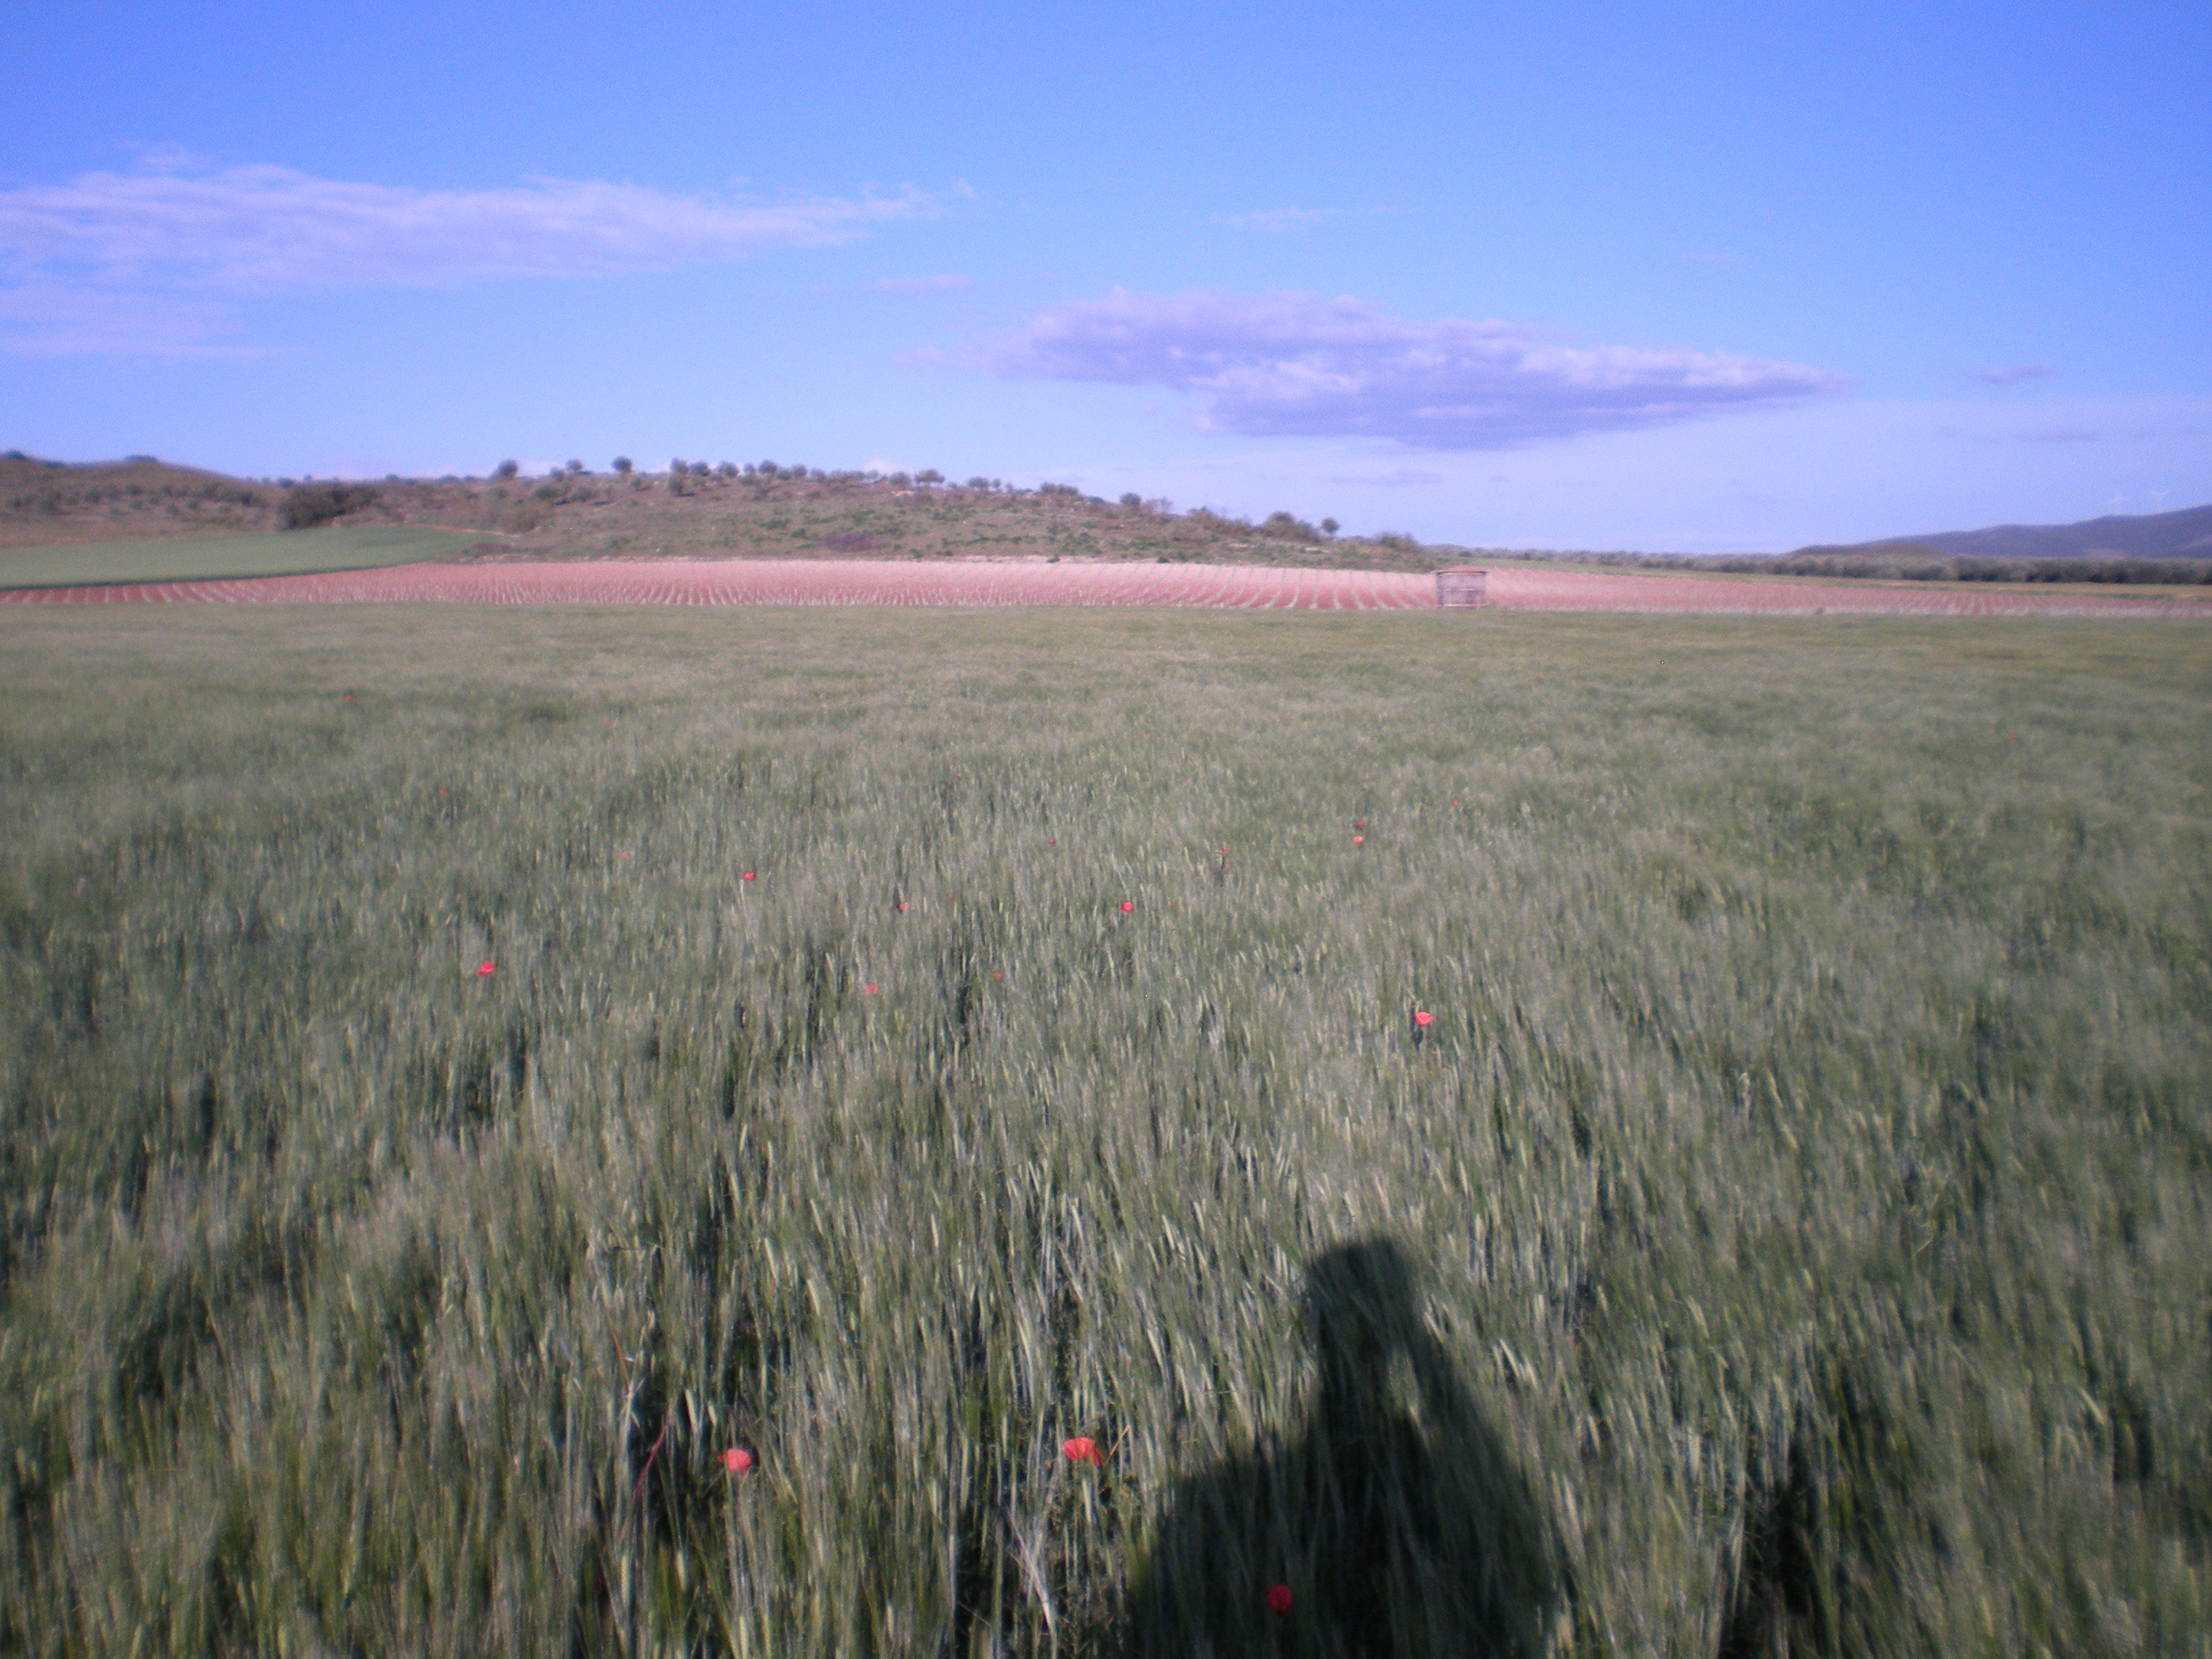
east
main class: Cropland
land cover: Barley
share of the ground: > 75 %
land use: Agriculture (excluding fallow land and kitchen gardens)
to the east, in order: Barley; Tracks; Grass margins; Vineyards; Grassland without tree/shrub cover
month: May
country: ES
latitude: 38.9143
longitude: -3.1931
